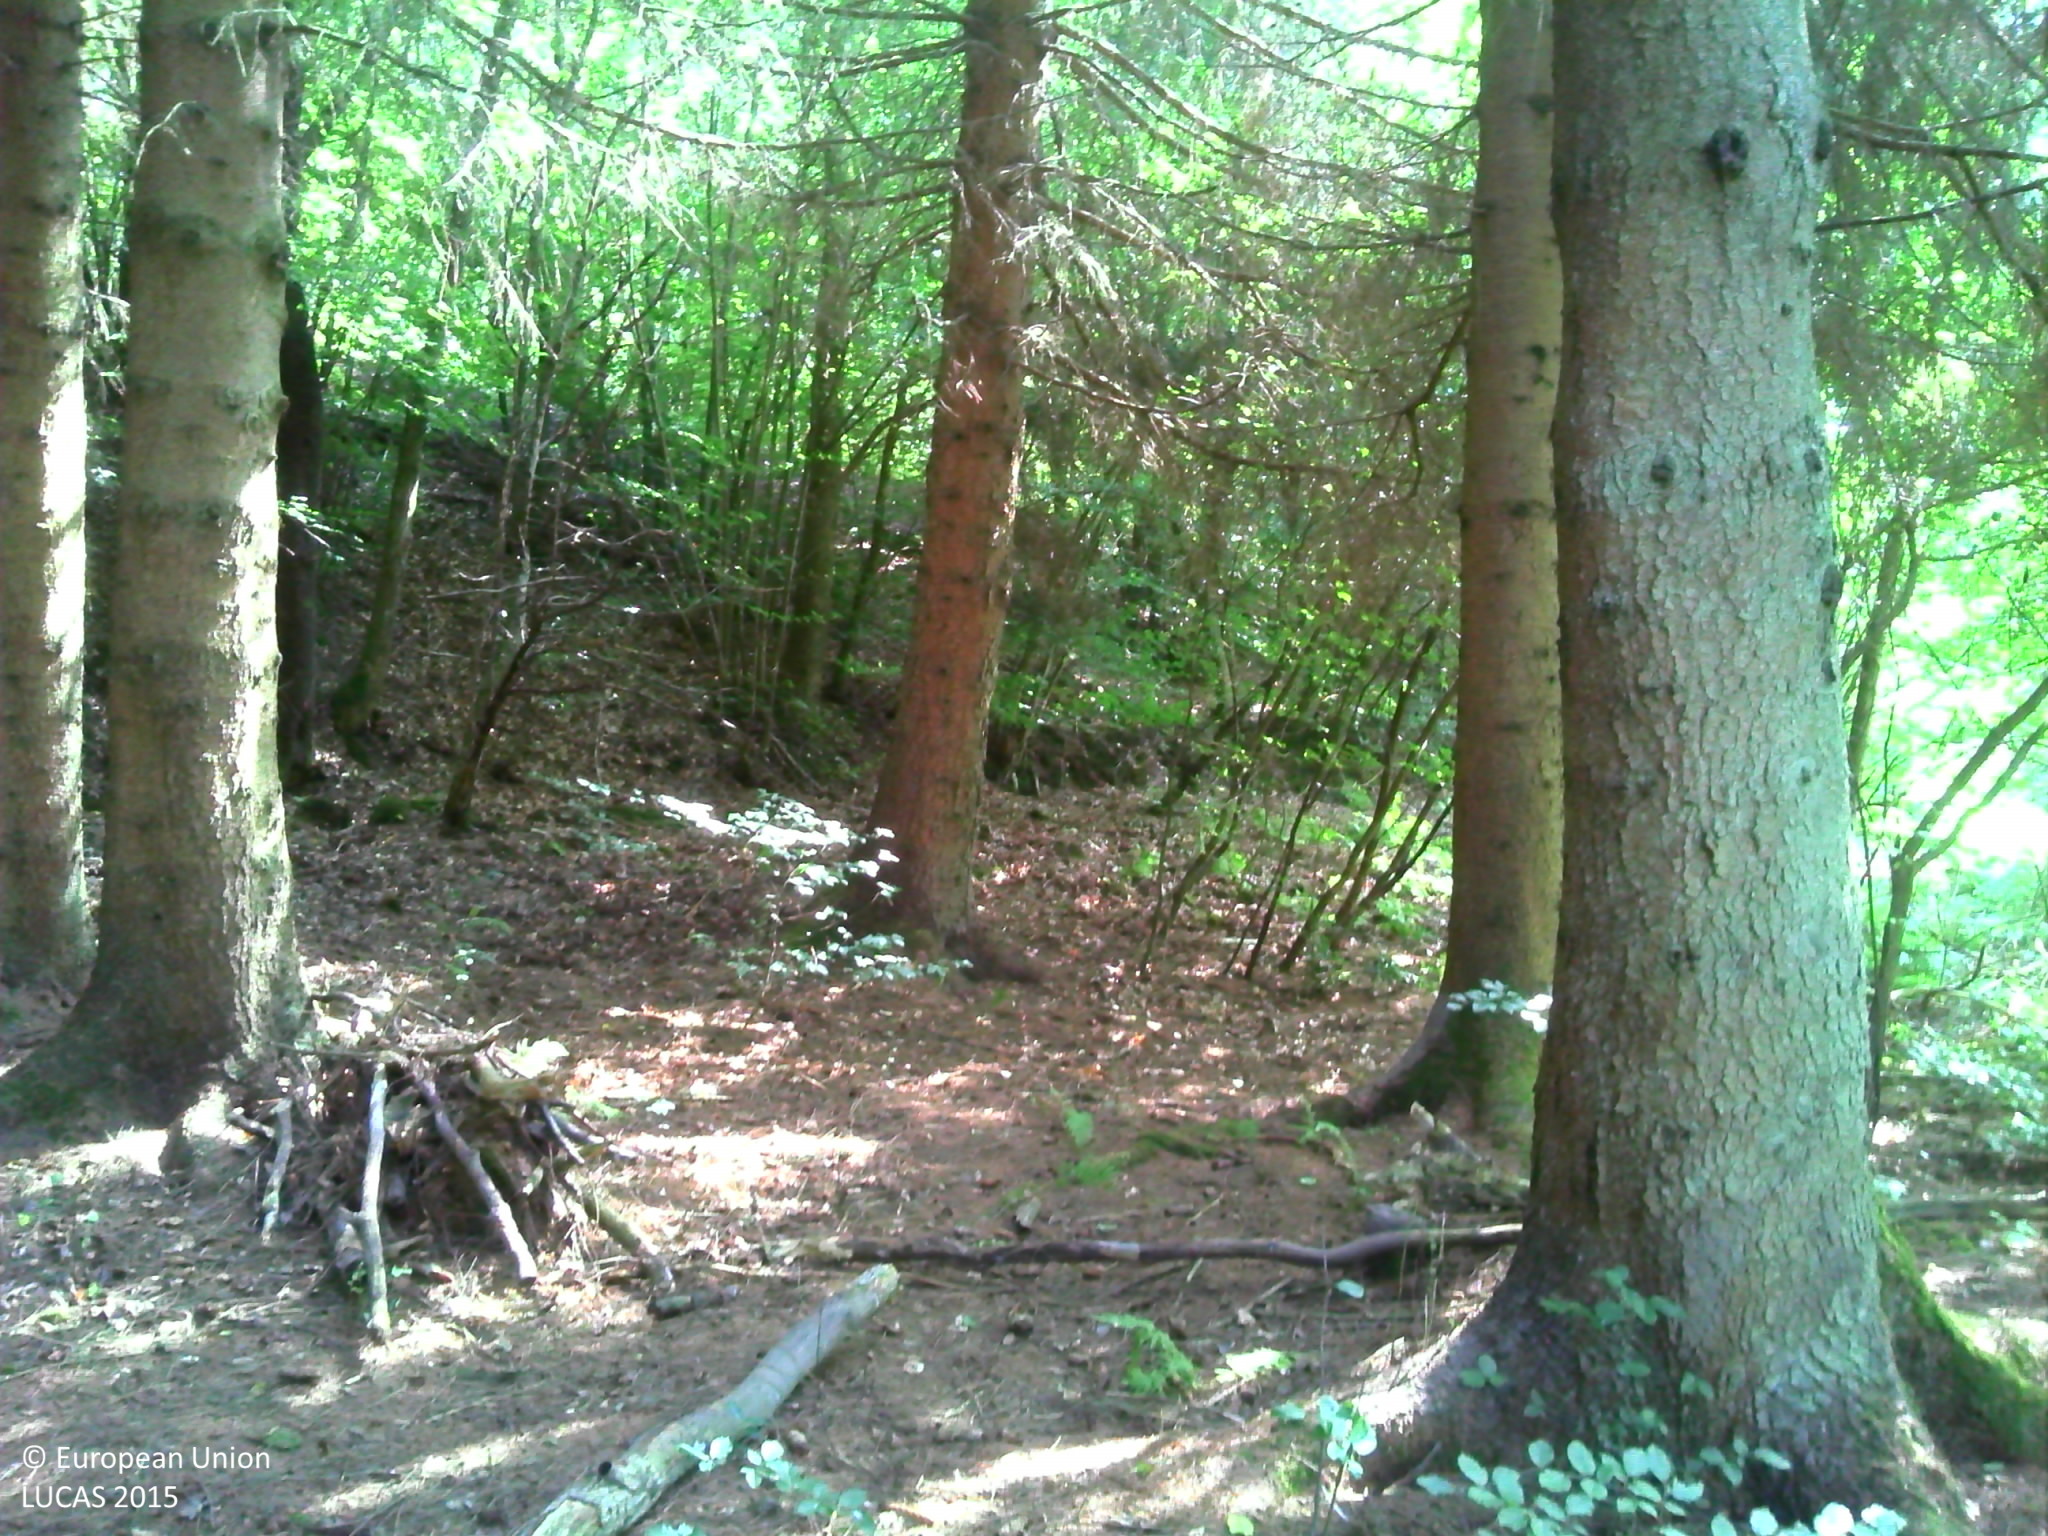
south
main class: Woodland
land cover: Spruce dominated mixed woodland
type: hemiboreal forest and nemoral coniferous forest and mixed broadleaved-coniferous forest
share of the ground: > 75 %
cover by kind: coniferous forest trees 70 %, broadleaved forest trees 30 %
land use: Forestry
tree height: > 5 m
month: August
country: FR
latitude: 48.9122
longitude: 7.3672
